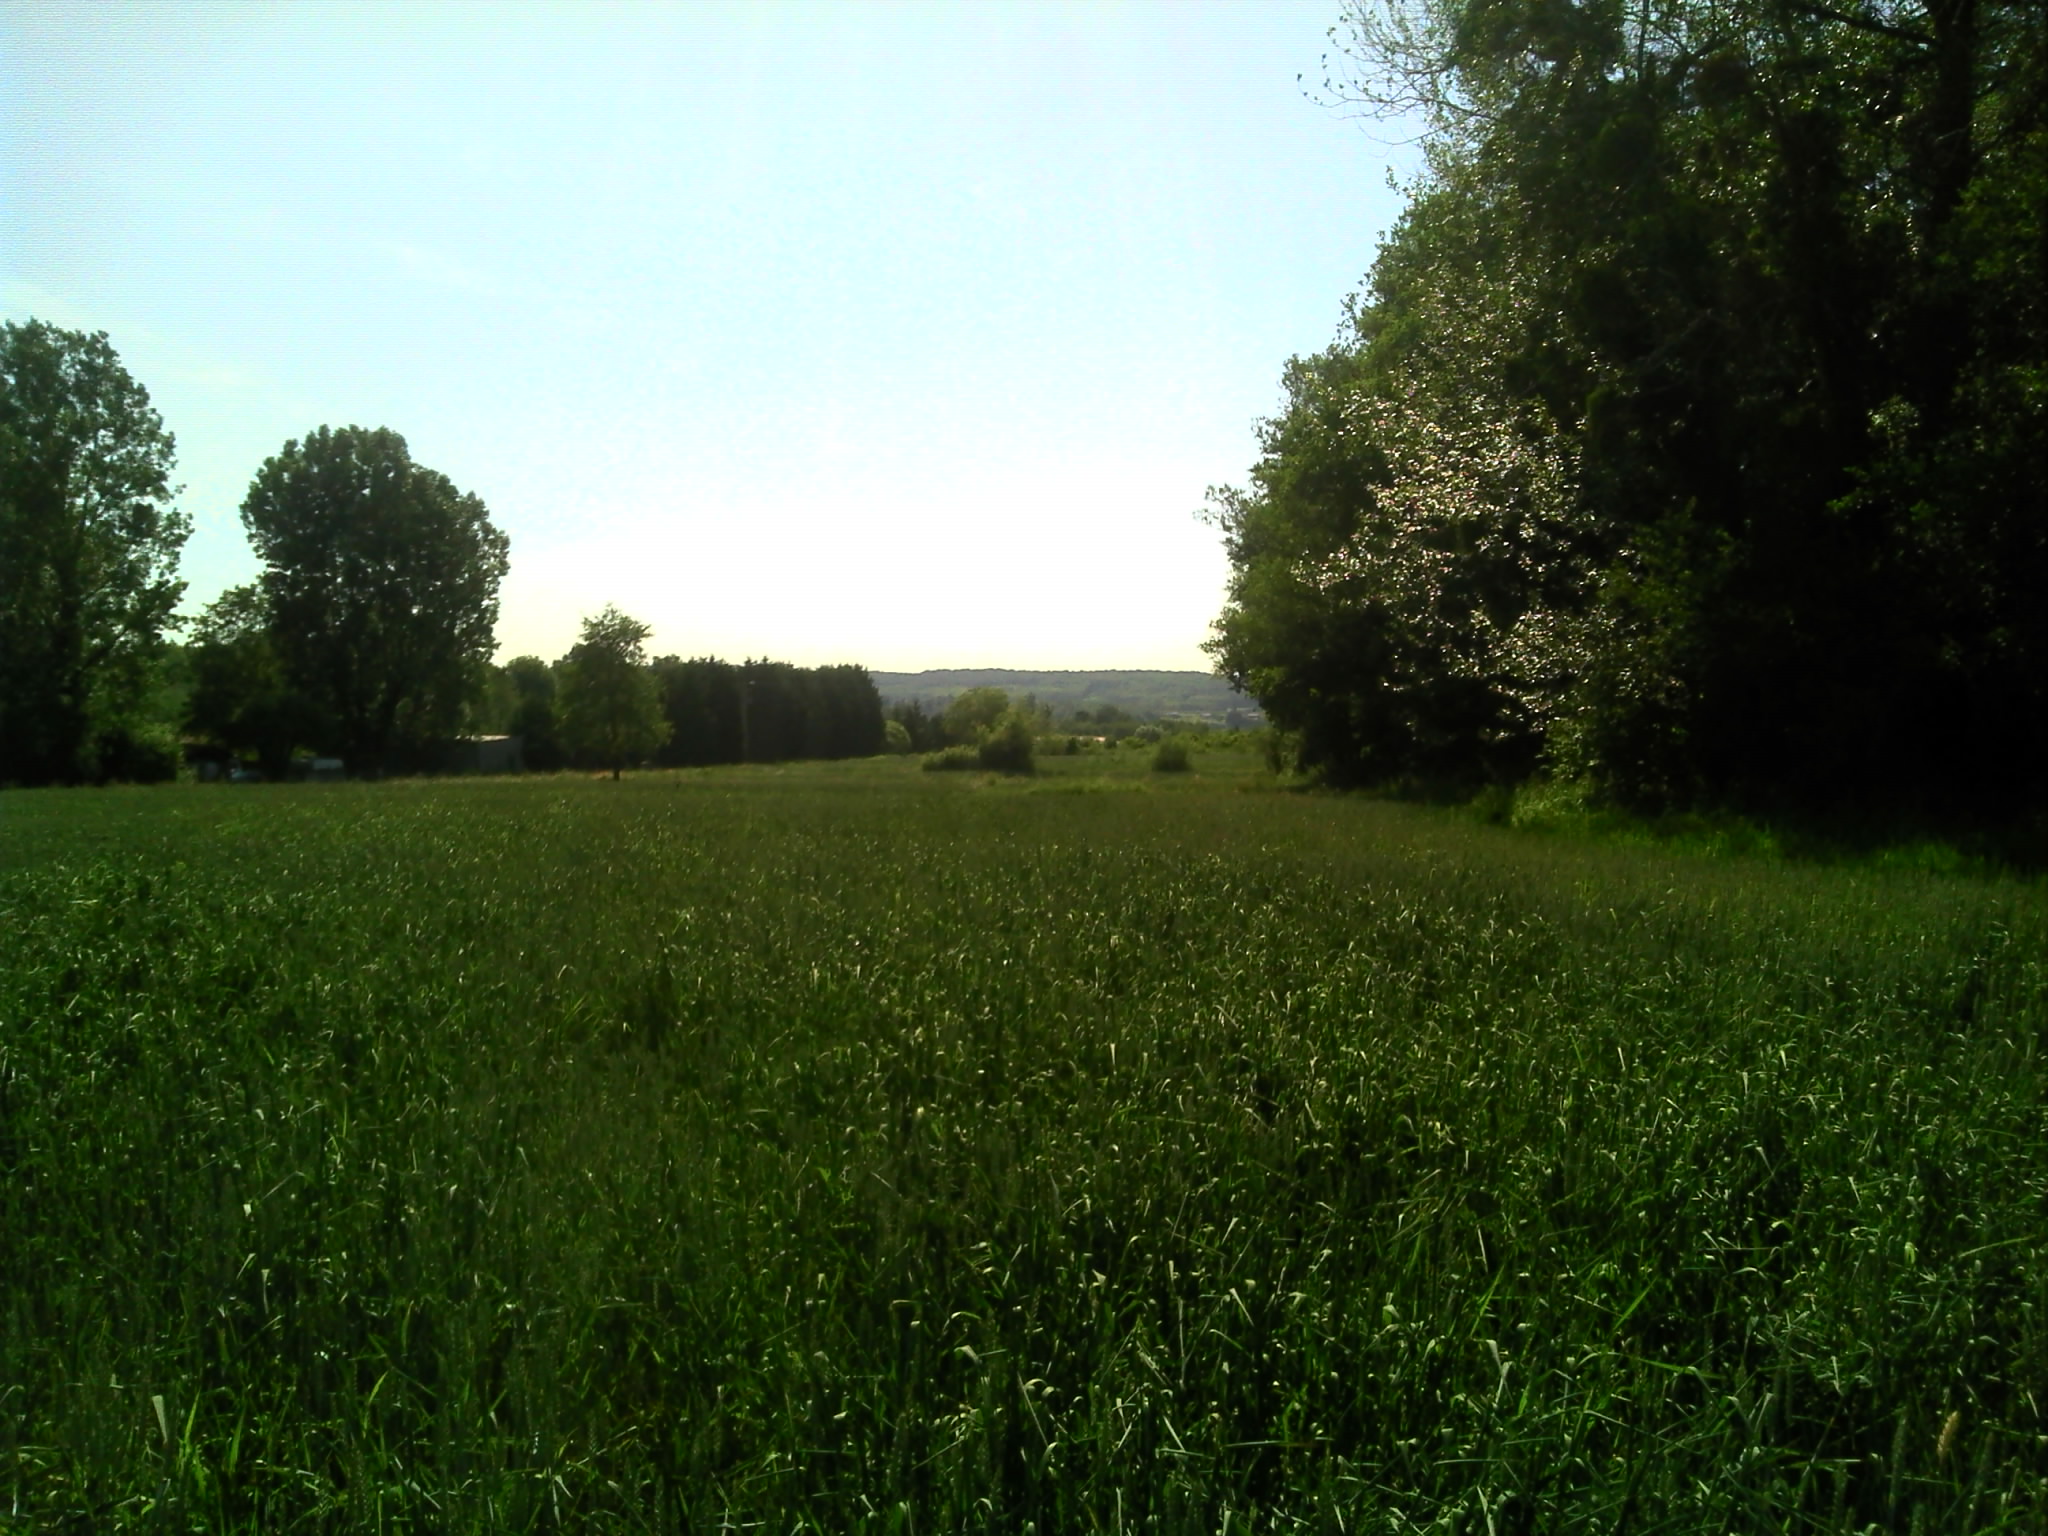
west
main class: Cropland
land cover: Common wheat
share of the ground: > 75 %
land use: Agriculture (excluding fallow land and kitchen gardens)
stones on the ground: < 10 %
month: May
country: FR
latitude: 46.5390
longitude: 4.9556
